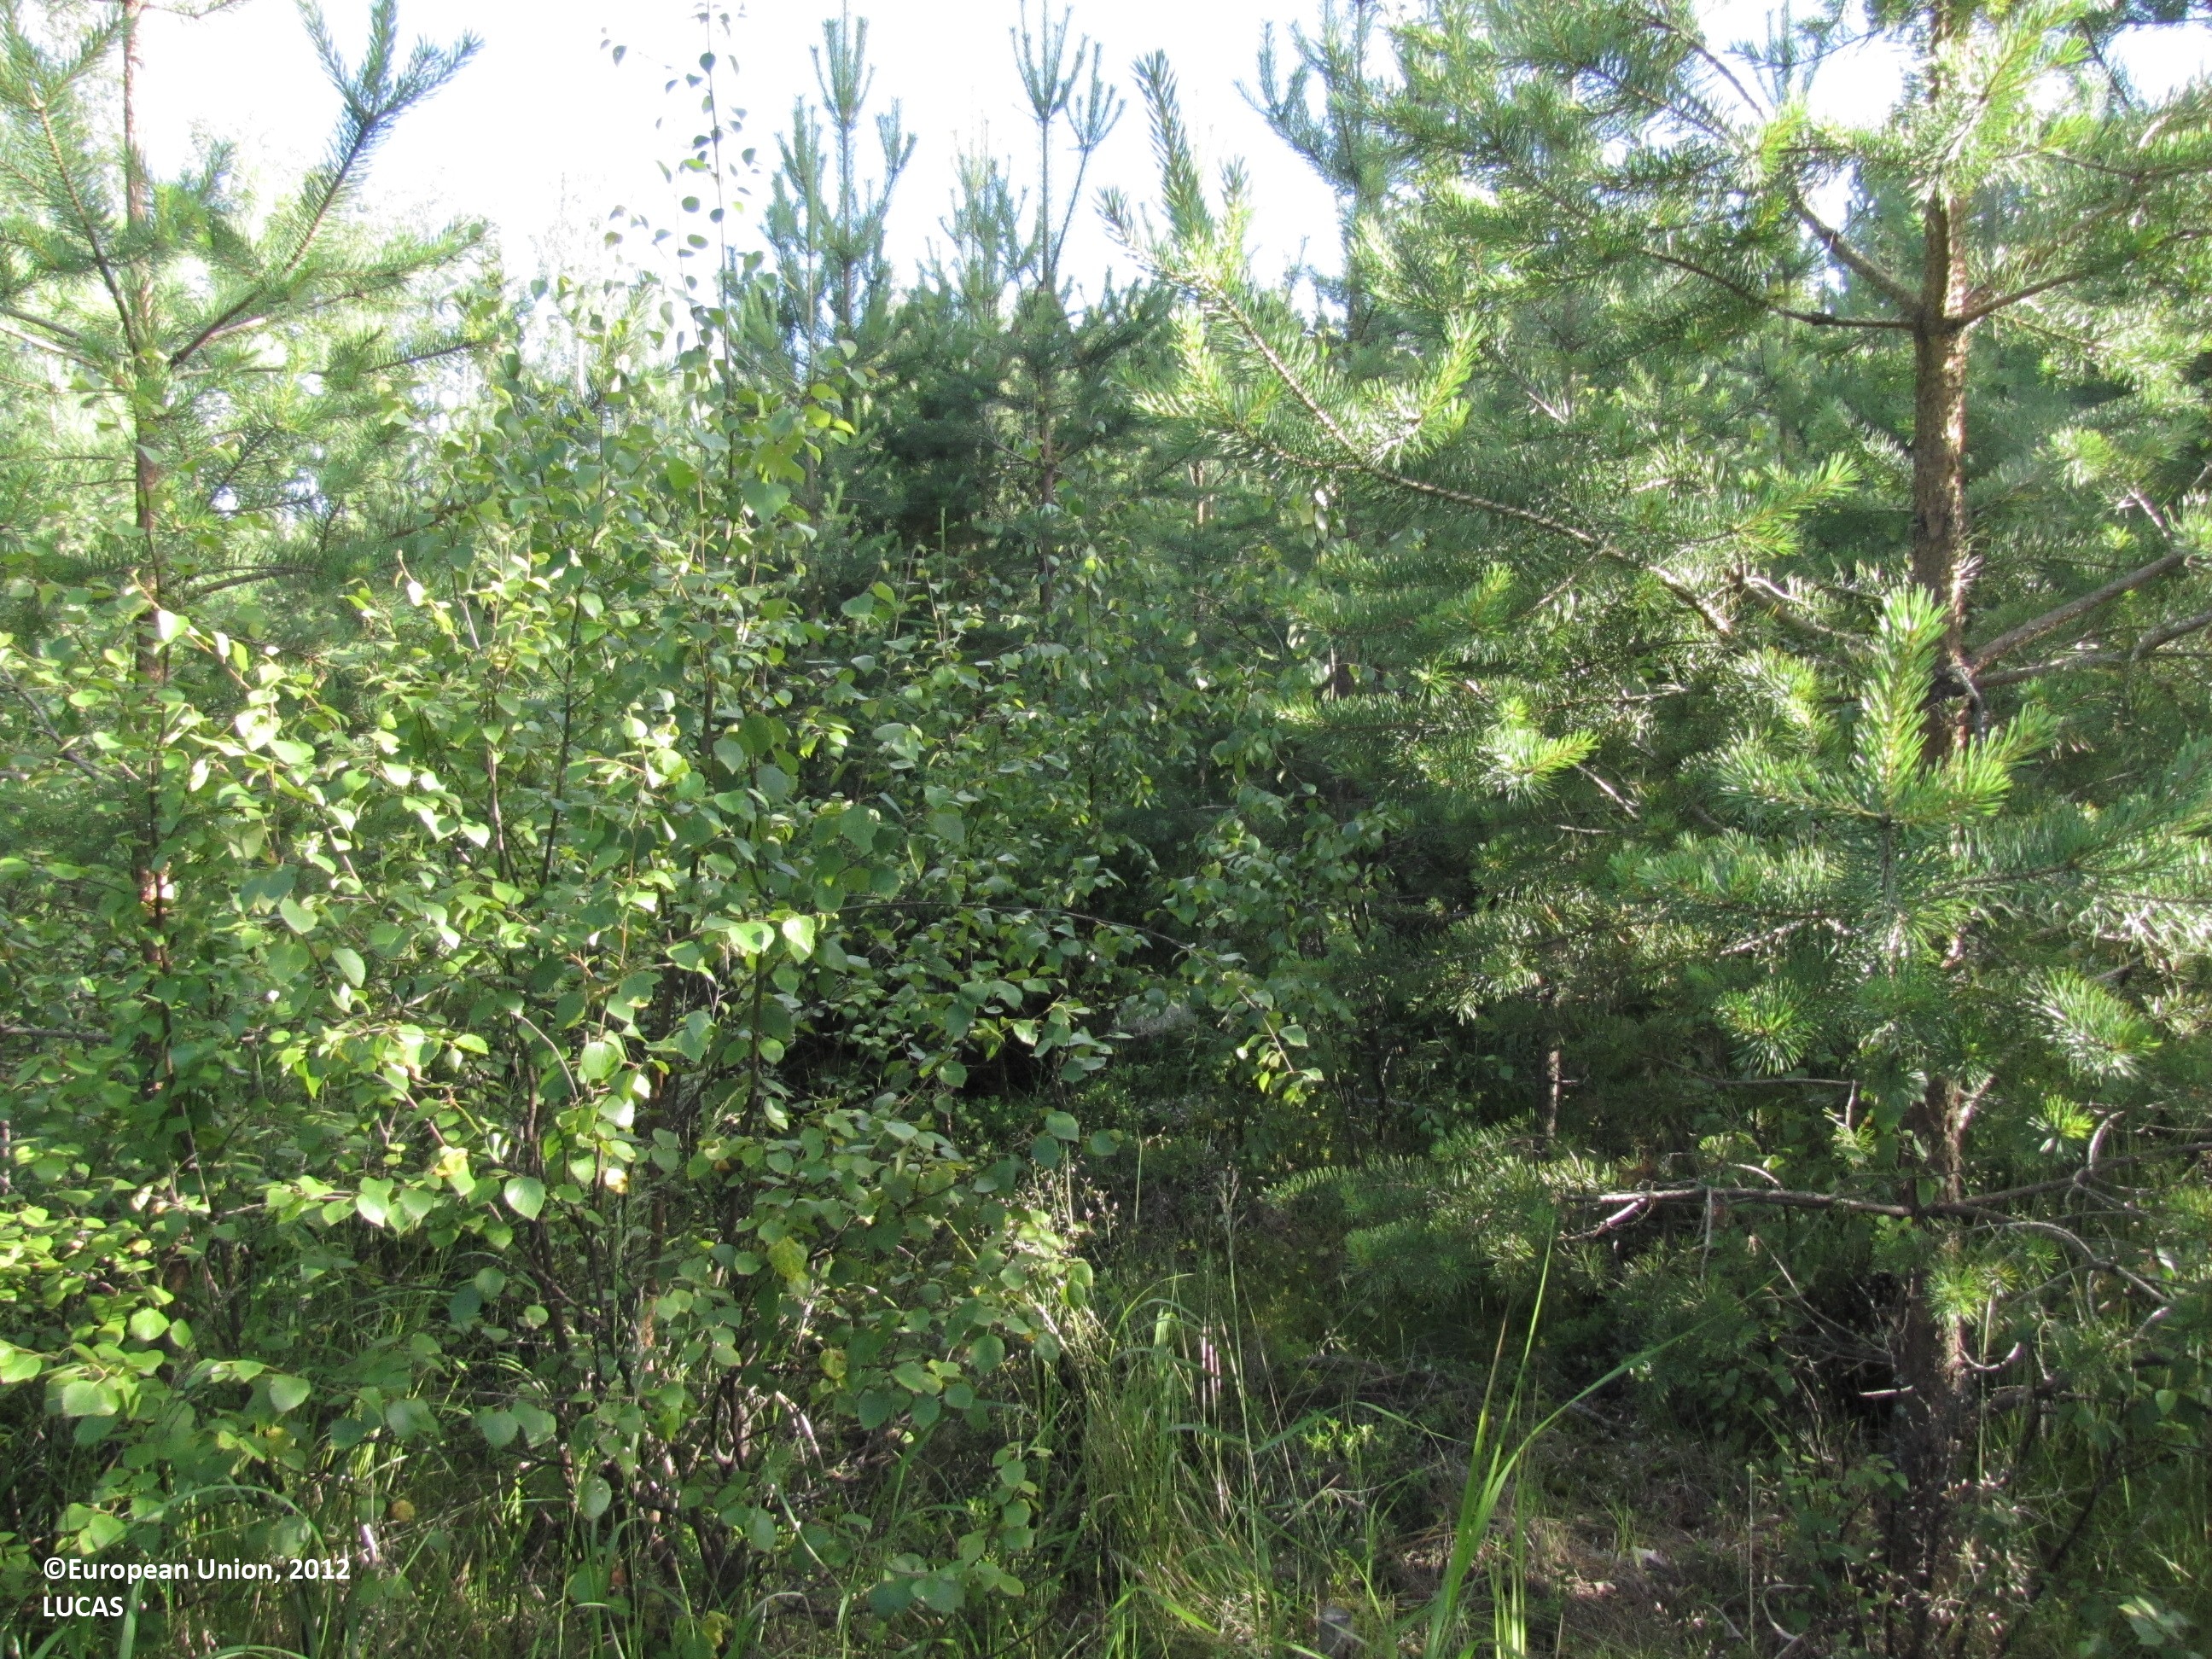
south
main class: Woodland
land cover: Pine dominated mixed woodland
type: boreal forest
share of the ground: > 75 %
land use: Forestry
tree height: < 5 m
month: July
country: FI
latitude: 62.3128
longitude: 23.0879
